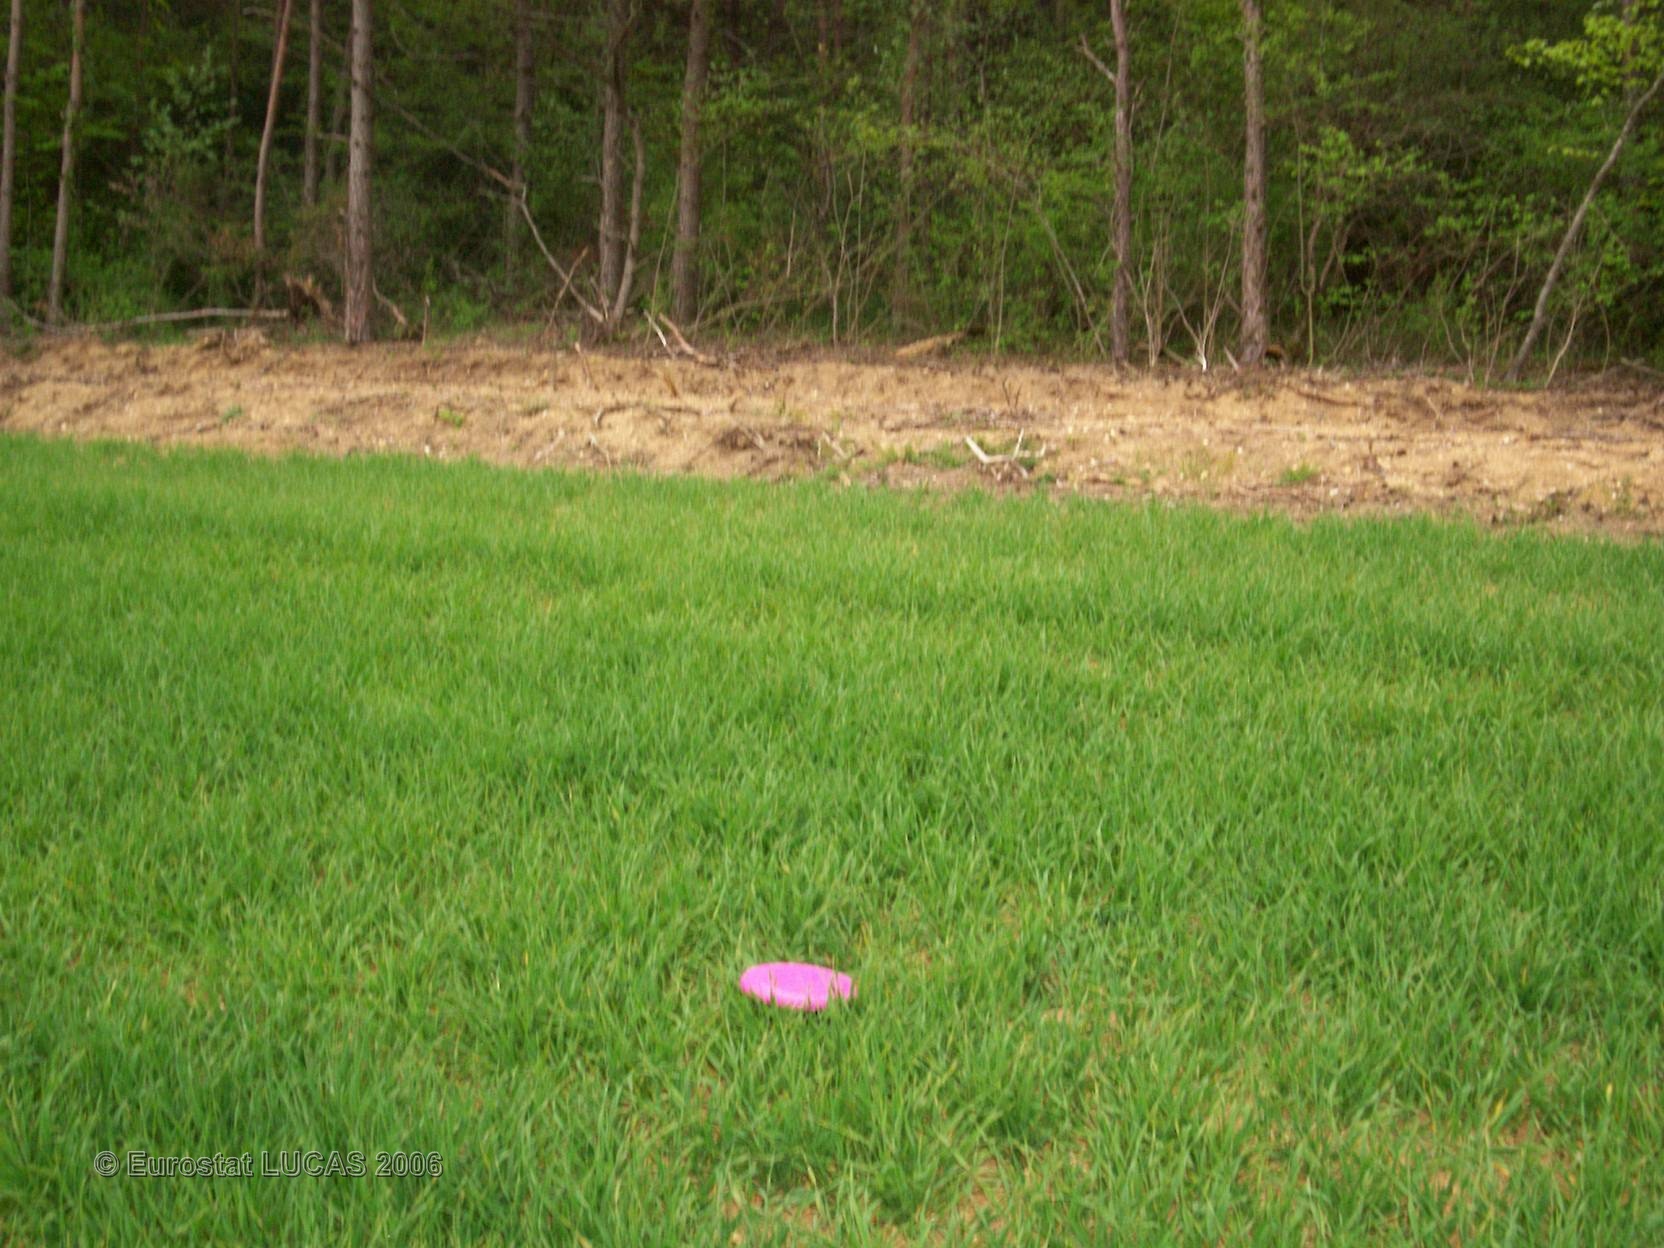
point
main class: Cropland
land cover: Barley
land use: Agriculture (excluding fallow land and kitchen gardens)
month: May
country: FR
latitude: 48.1497
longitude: 3.9880
